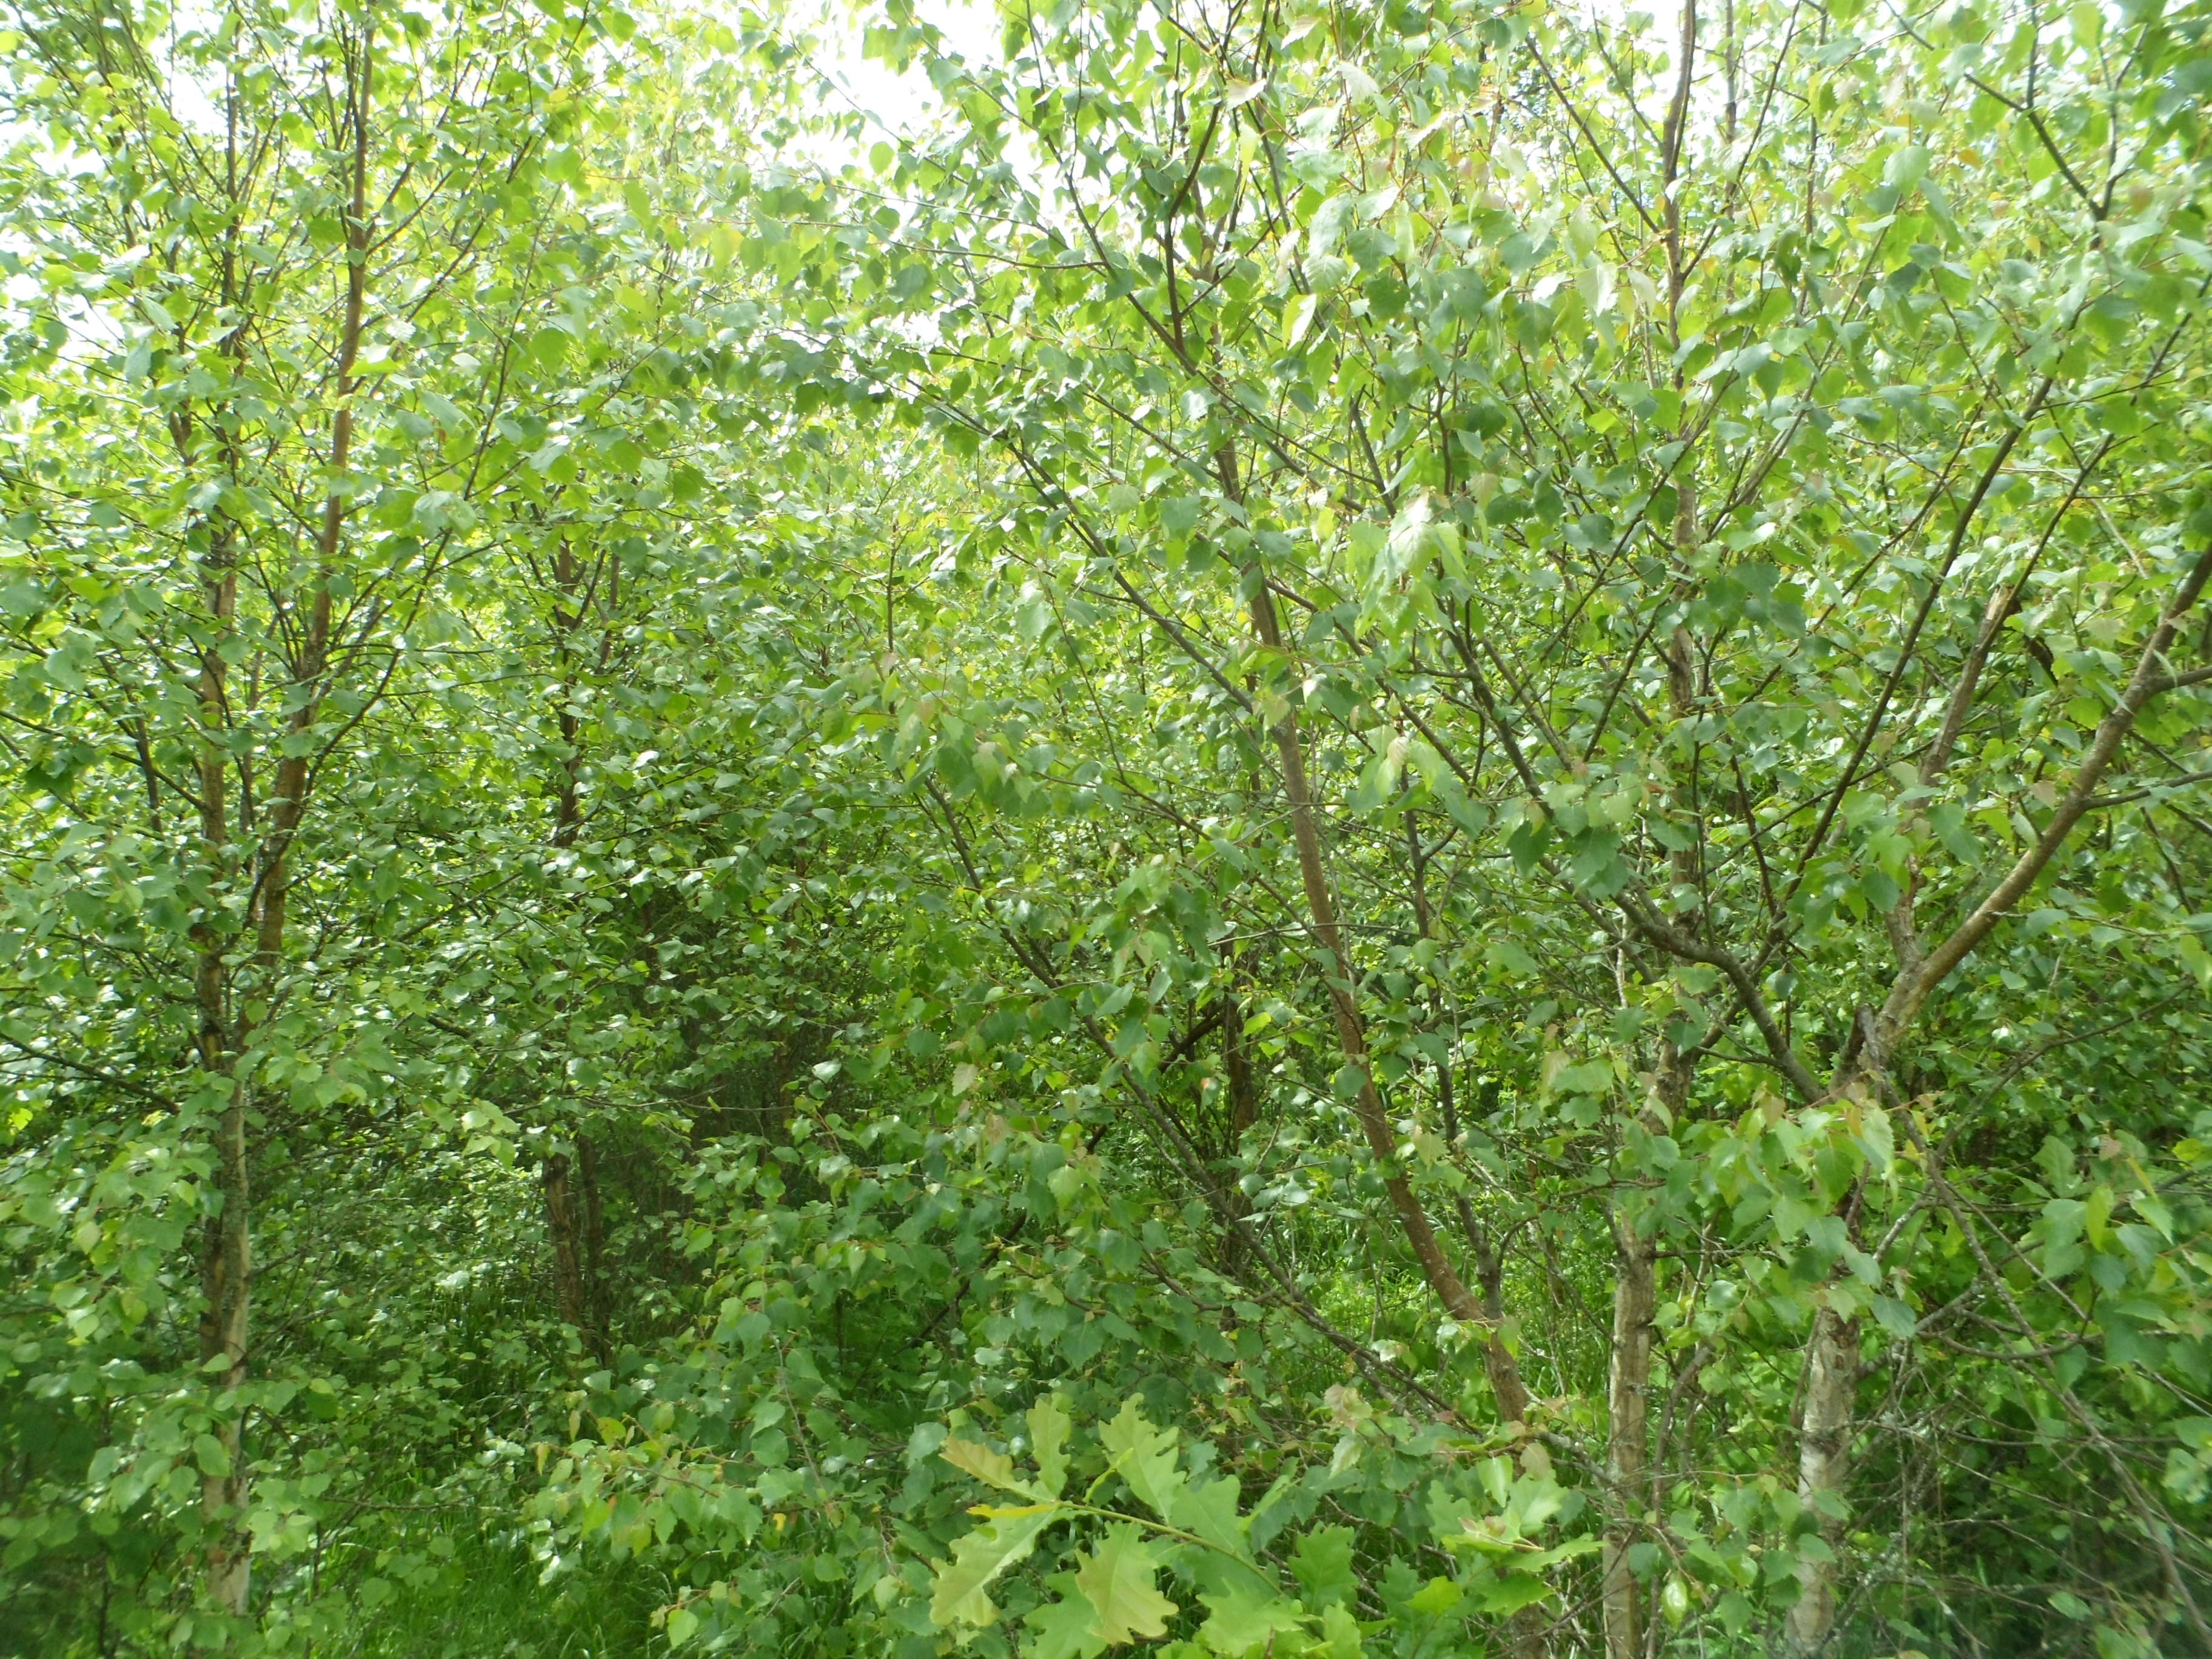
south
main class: Woodland
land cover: Broadleaved woodland
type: boreal forest
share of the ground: 50 - 75 %
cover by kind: broadleaved forest trees 65 %, herbaceous plants 30 %, coniferous forest trees 5 %
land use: Forestry
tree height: < 5 m
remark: Clear cut
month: June
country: SE
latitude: 56.9445
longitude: 14.2869
